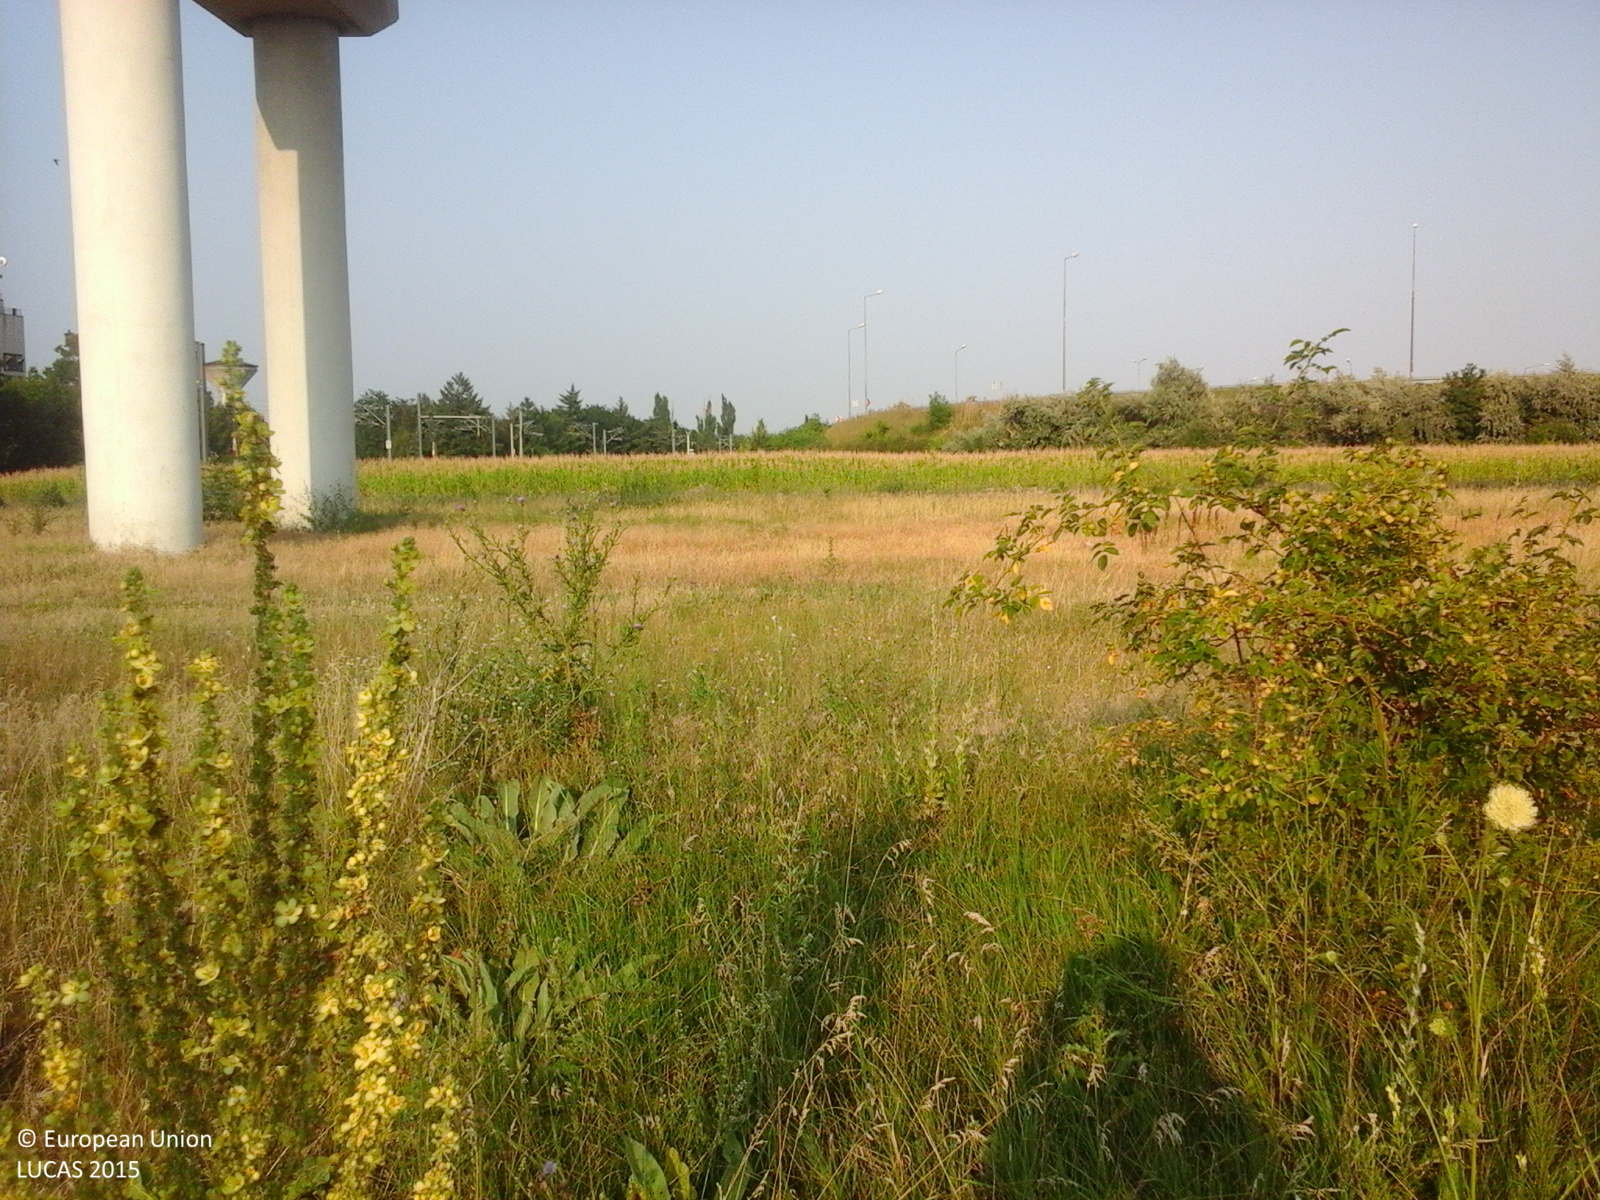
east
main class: Grassland
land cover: Spontaneously vegetated surfaces
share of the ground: > 75 %
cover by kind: herbaceous plants 100 %
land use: Semi-natural and natural areas not in use
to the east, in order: Spontaneously vegetated surfaces; Paved roads, cycling and walking lanes; Spontaneously vegetated surfaces; Maize; Spontaneously vegetated surfaces; Fences; Abandoned hedges; Fences; Spontaneously vegetated surfaces
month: July
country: RO
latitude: 44.4498
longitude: 26.5144
